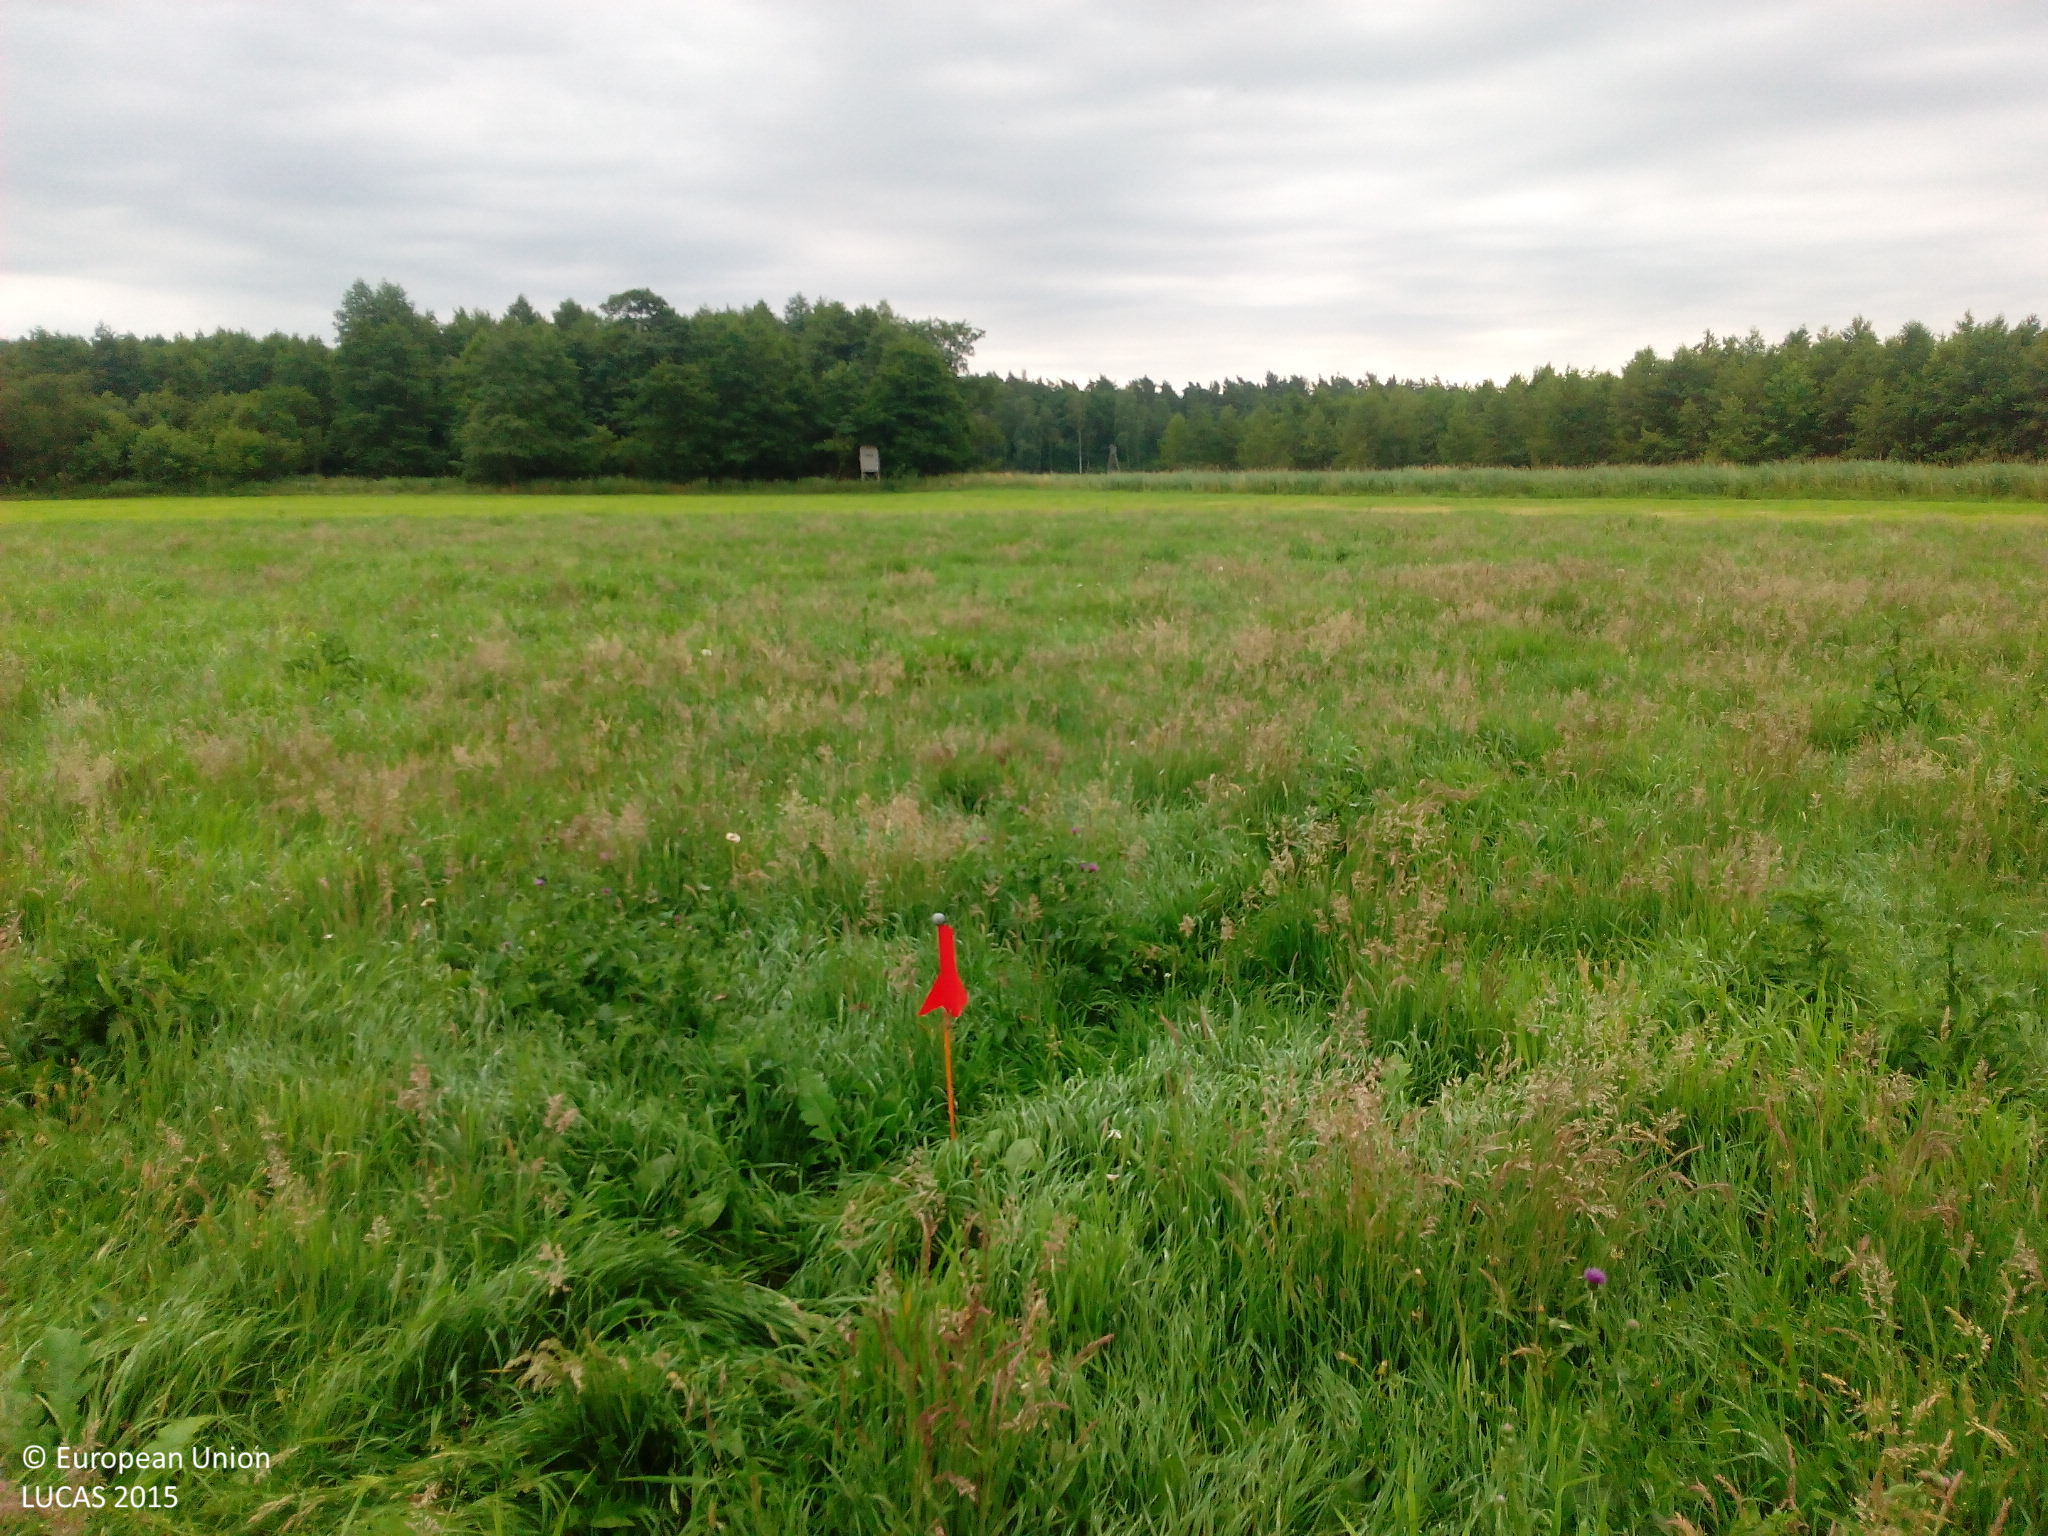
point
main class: Grassland
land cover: Grassland without tree/shrub cover
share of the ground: > 75 %
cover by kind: herbaceous plants 100 %
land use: Agriculture (excluding fallow land and kitchen gardens)
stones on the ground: < 10 %
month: July
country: DE
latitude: 53.5448
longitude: 14.2111
